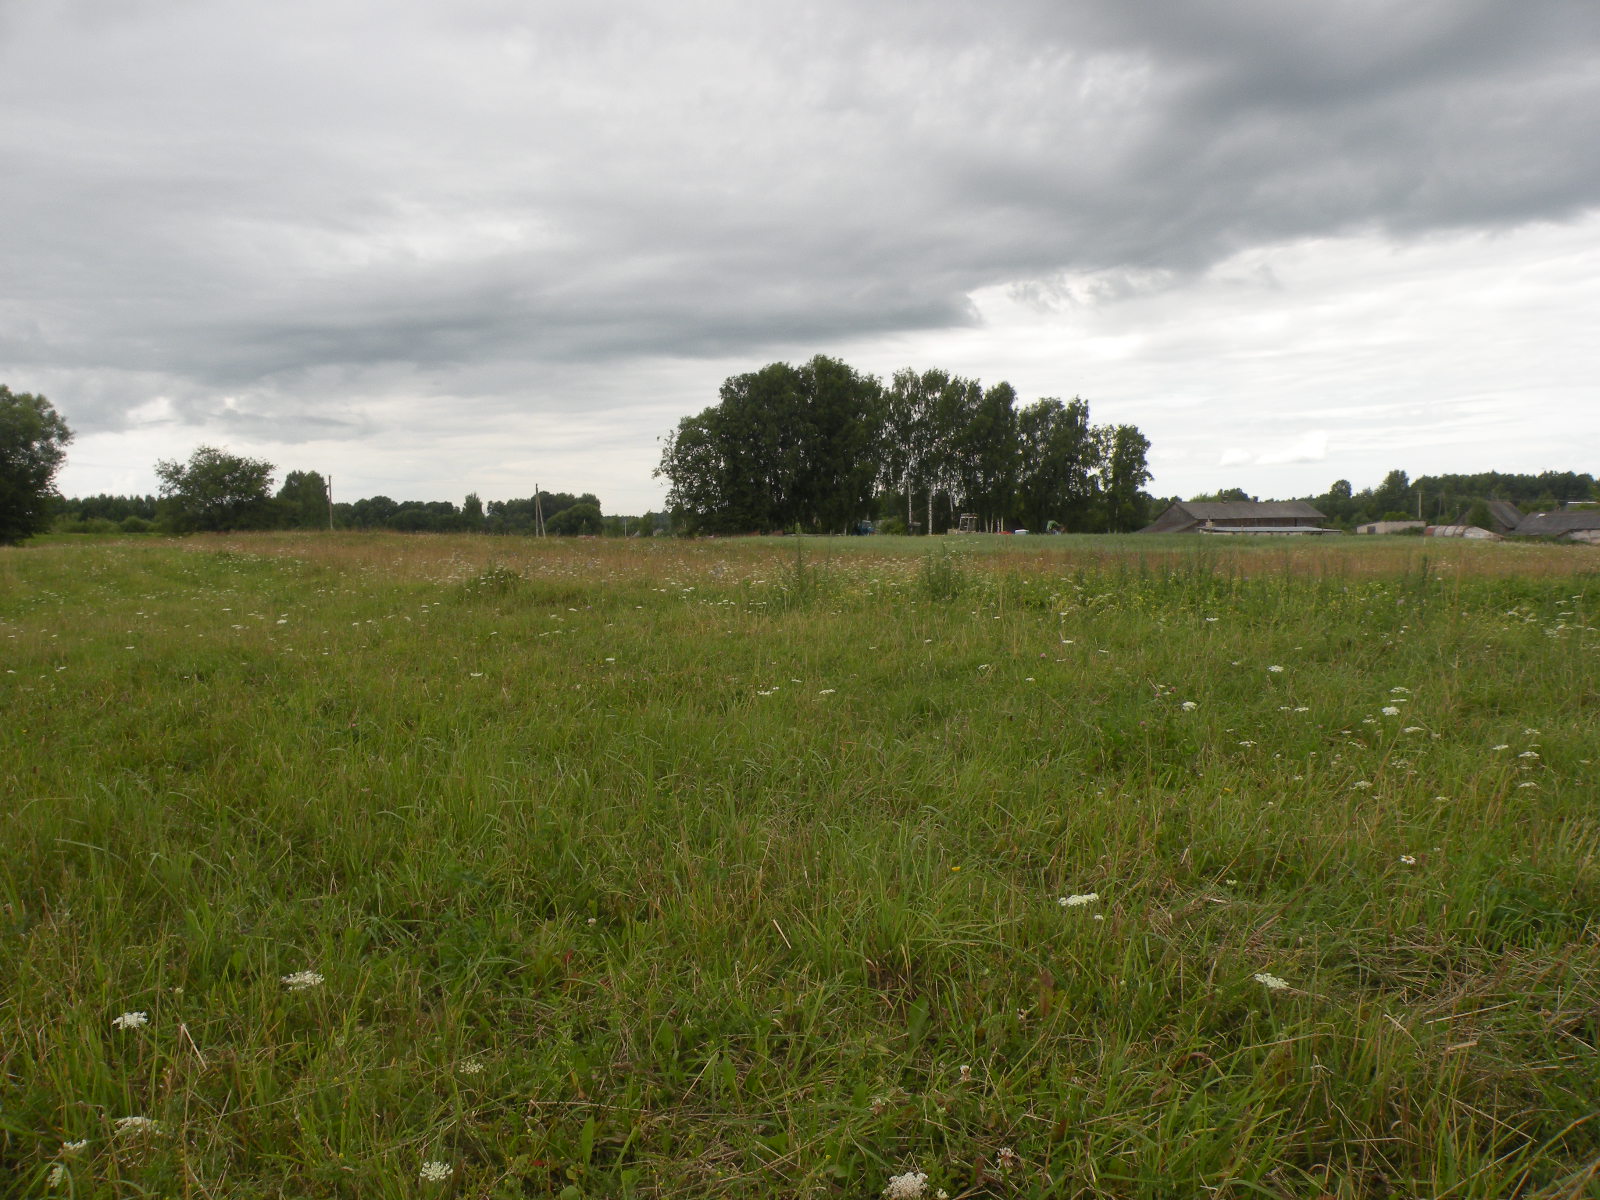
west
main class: Grassland
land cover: Grassland without tree/shrub cover
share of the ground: > 75 %
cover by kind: herbaceous plants 100 %
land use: Agriculture (excluding fallow land and kitchen gardens)
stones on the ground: < 10 %
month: July
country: LV
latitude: 55.8573
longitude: 26.9552
